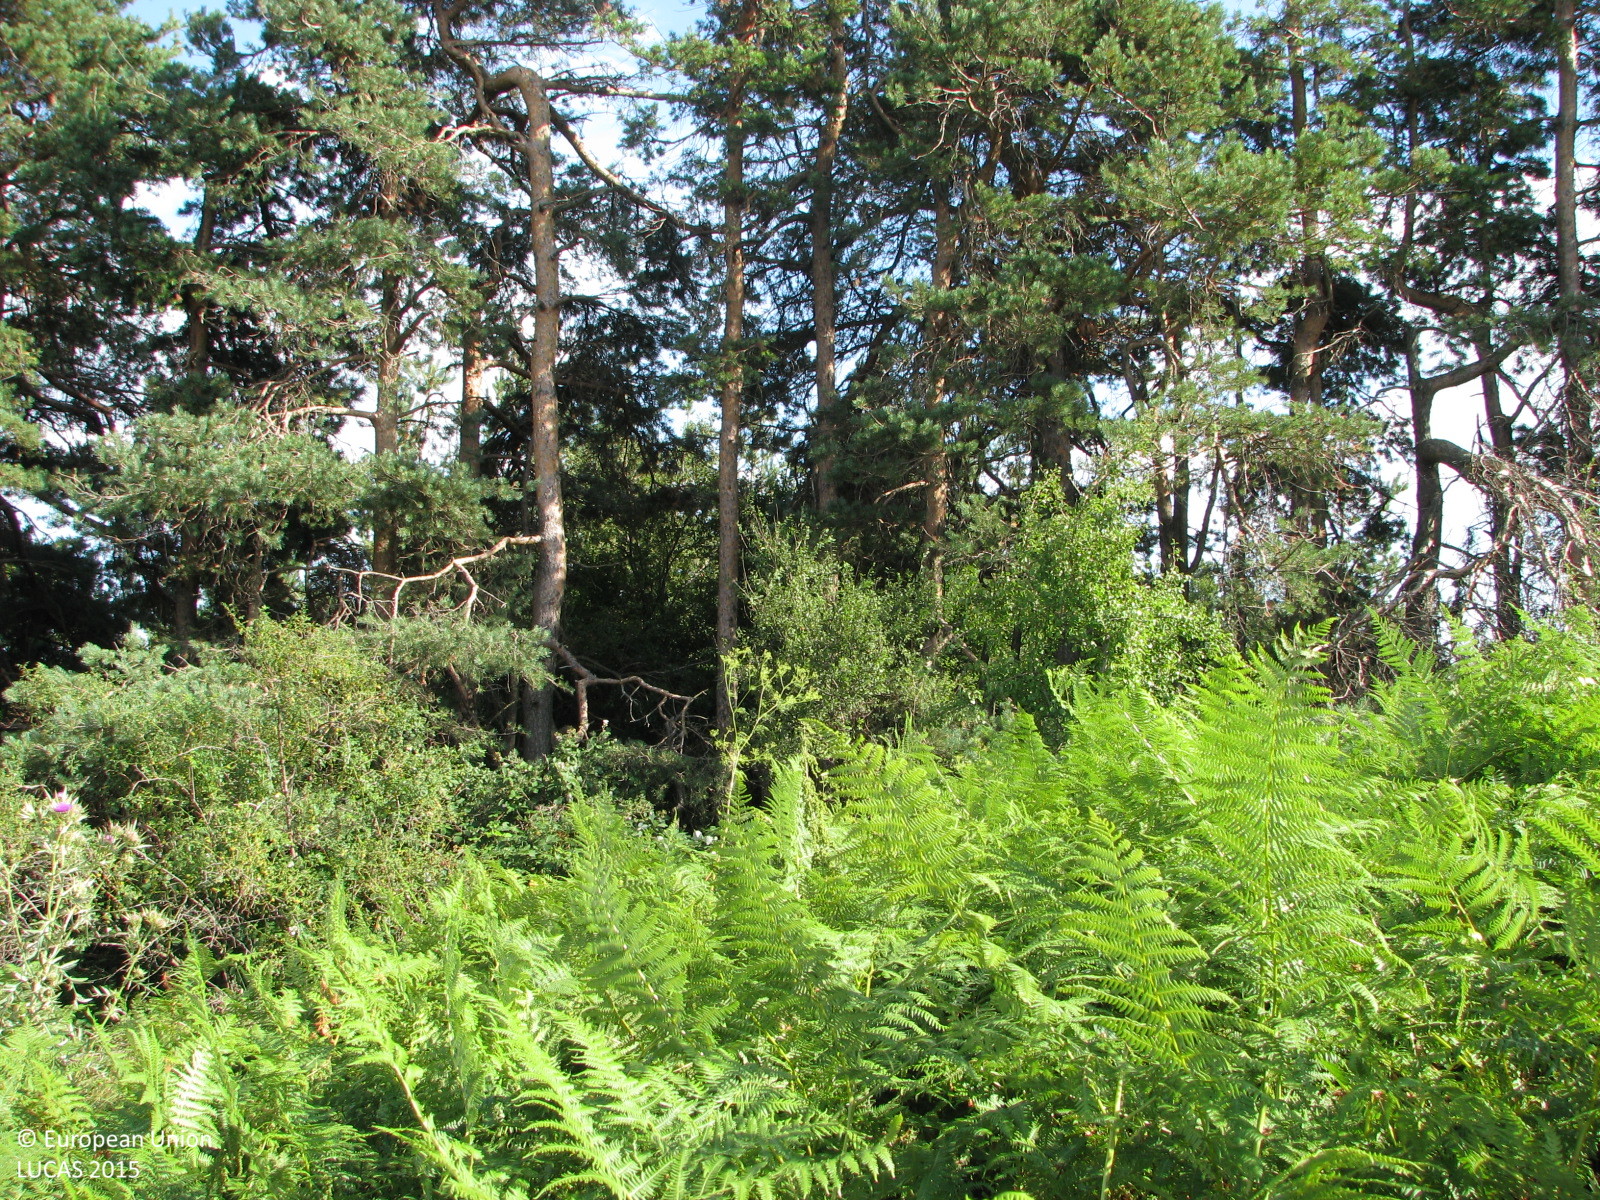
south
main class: Shrubland
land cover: Shrubland with sparse tree cover
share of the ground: > 75 %
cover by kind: shrubs 75 %, herbaceous plants 20 %, coniferous forest trees 5 %
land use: Semi-natural and natural areas not in use
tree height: > 5 m
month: August
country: BG
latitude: 42.8032
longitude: 26.2430
